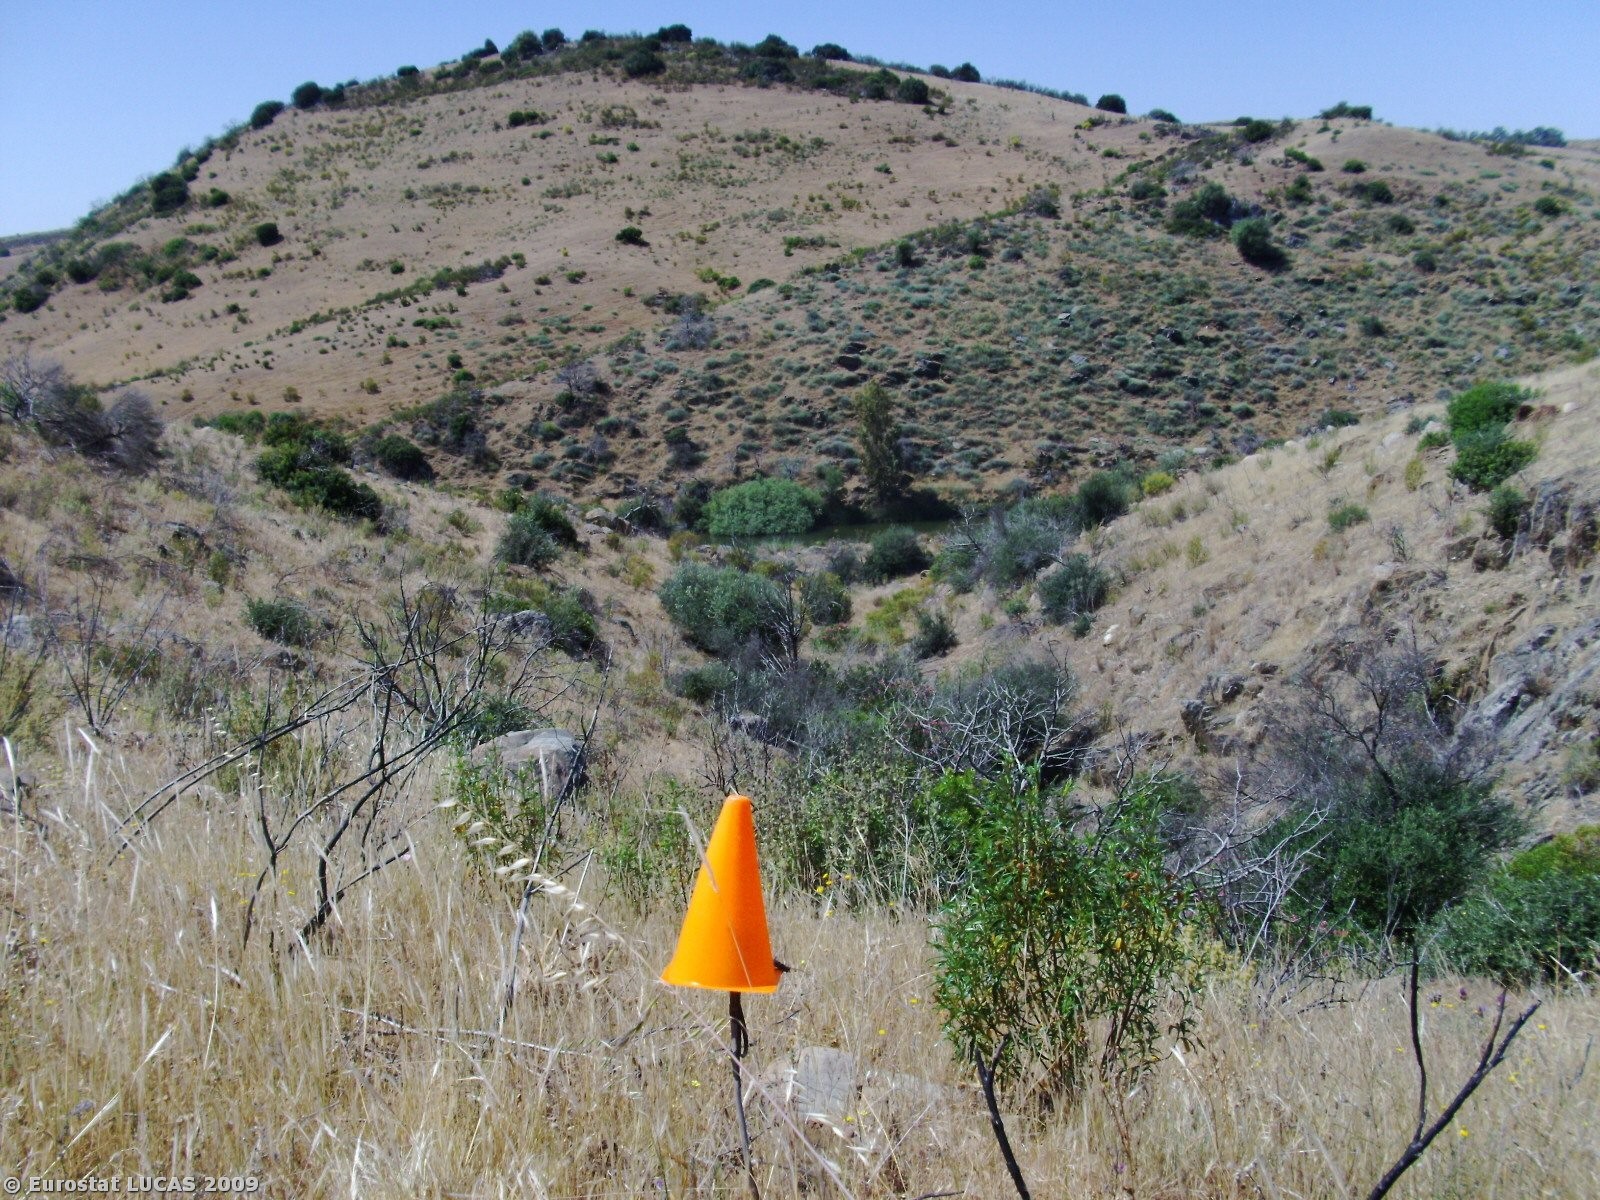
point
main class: Shrubland
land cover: Shrubland without tree cover
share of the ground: 50 - 75 %
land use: Agriculture (excluding fallow land and kitchen gardens)
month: May
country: PT
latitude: 37.6129
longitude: -7.6767
